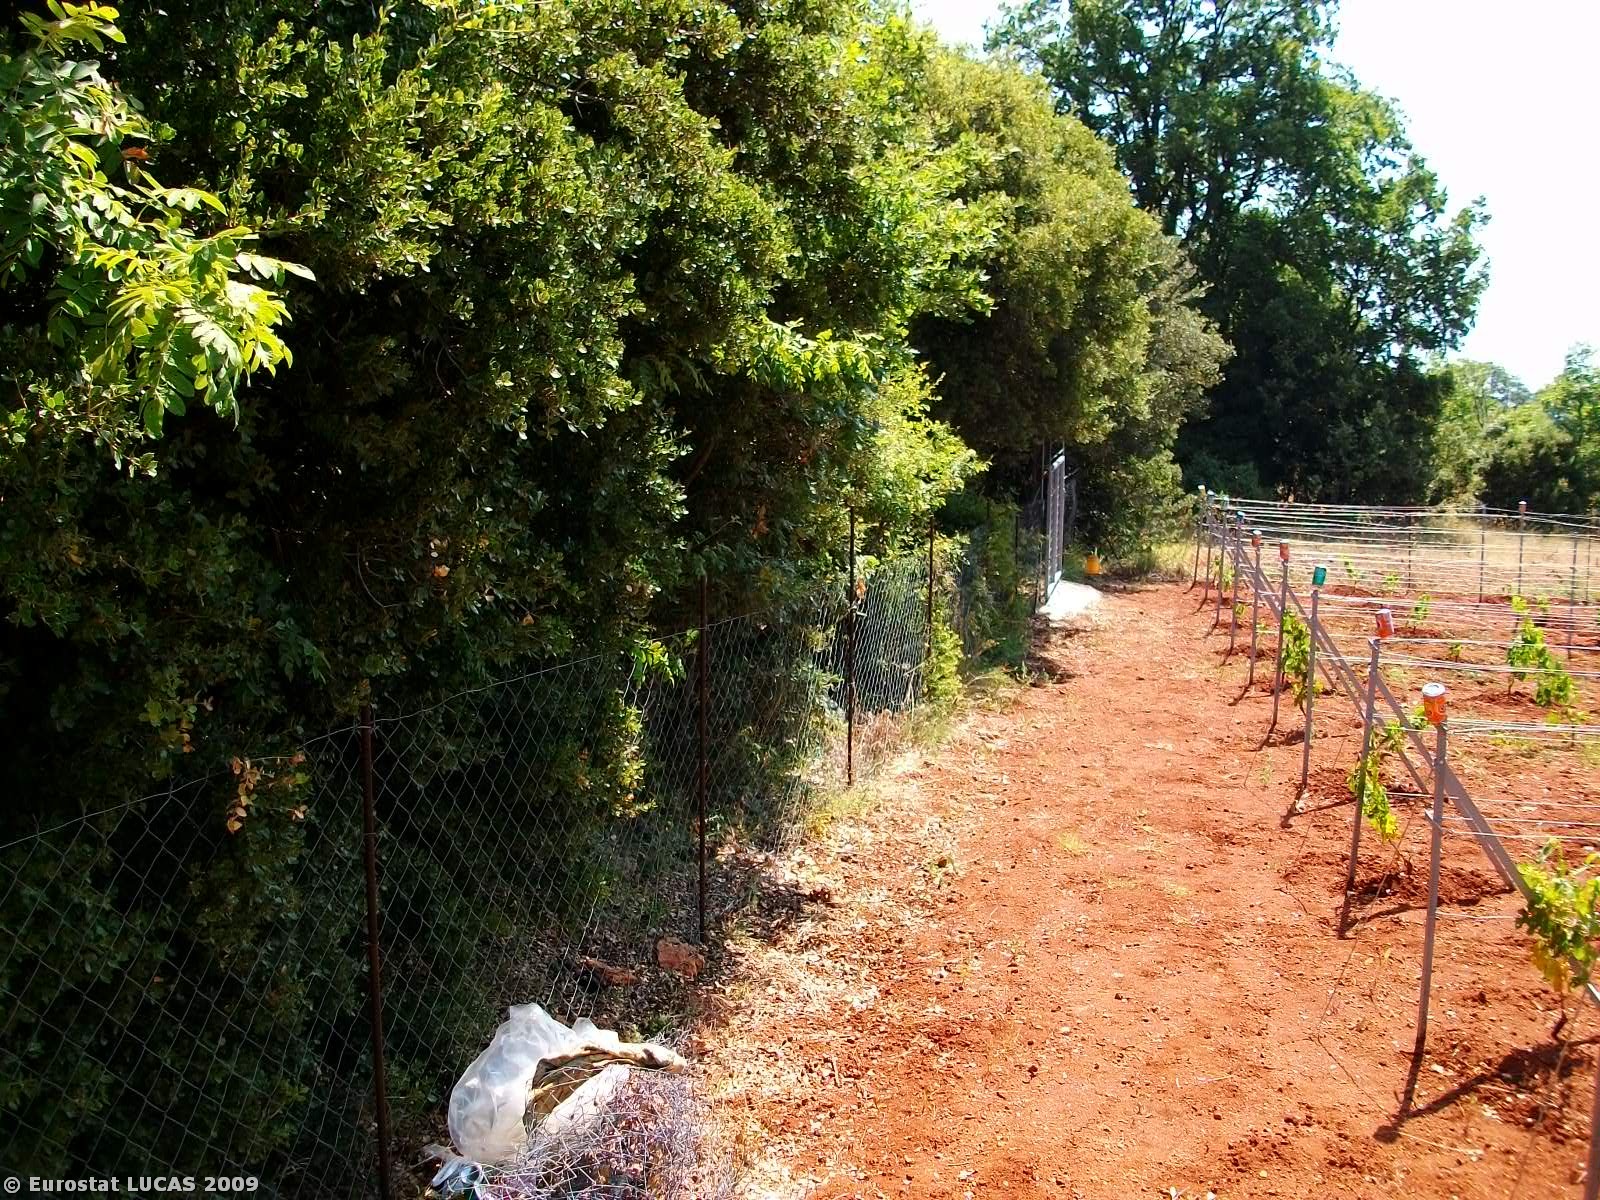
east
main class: Cropland
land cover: Vineyards
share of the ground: 10 - 25 %
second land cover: Bare land
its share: 50 - 75 %
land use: Agriculture (excluding fallow land and kitchen gardens)
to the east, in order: Vineyards; Bare land; Fences; Broadleaved woodland; Paved roads, cycling and walking lanes; Broadleaved woodland; Vineyards; Grassland with sparse tree/shrub cover; Shruby margins; Vineyards; Broadleaved woodland; Paved roads, cycling and walking lanes; Shrubland with sparse tree cover
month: July
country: GR
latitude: 40.2364
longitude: 21.7328
